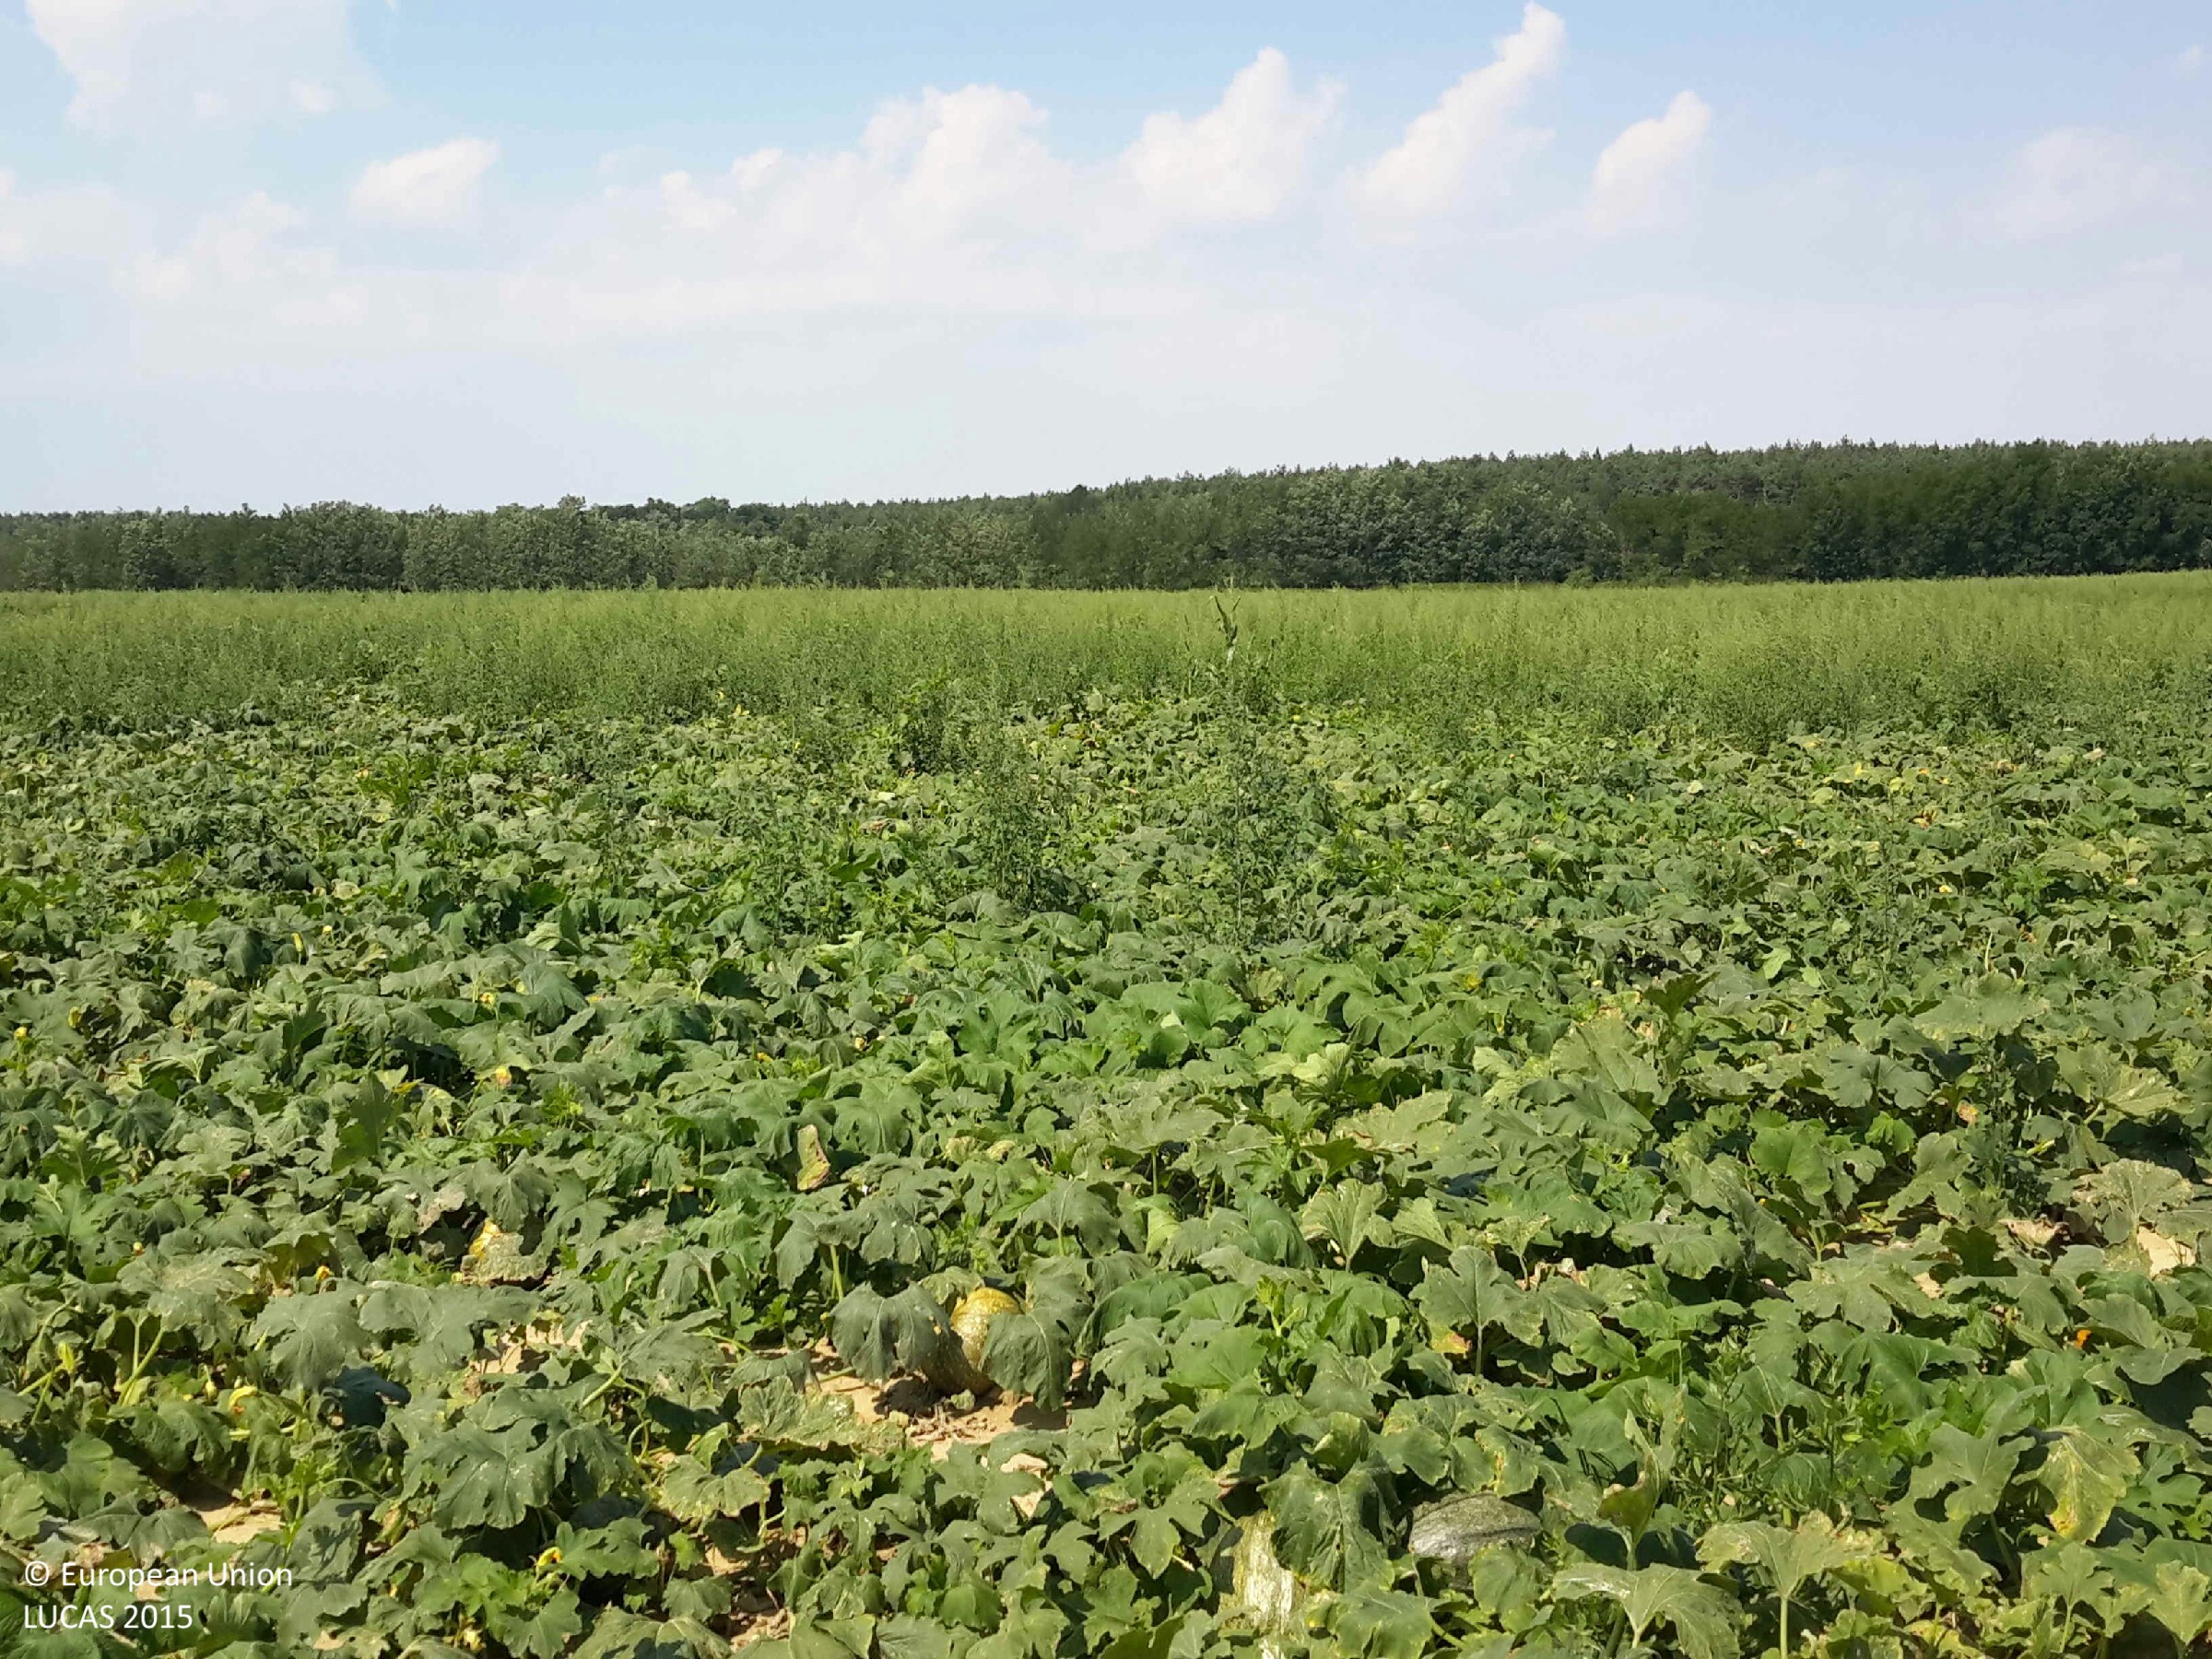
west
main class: Cropland
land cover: Other fibre and oleaginous crops
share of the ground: > 75 %
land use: Agriculture (excluding fallow land and kitchen gardens)
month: July
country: HU
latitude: 47.1192
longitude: 16.6595
